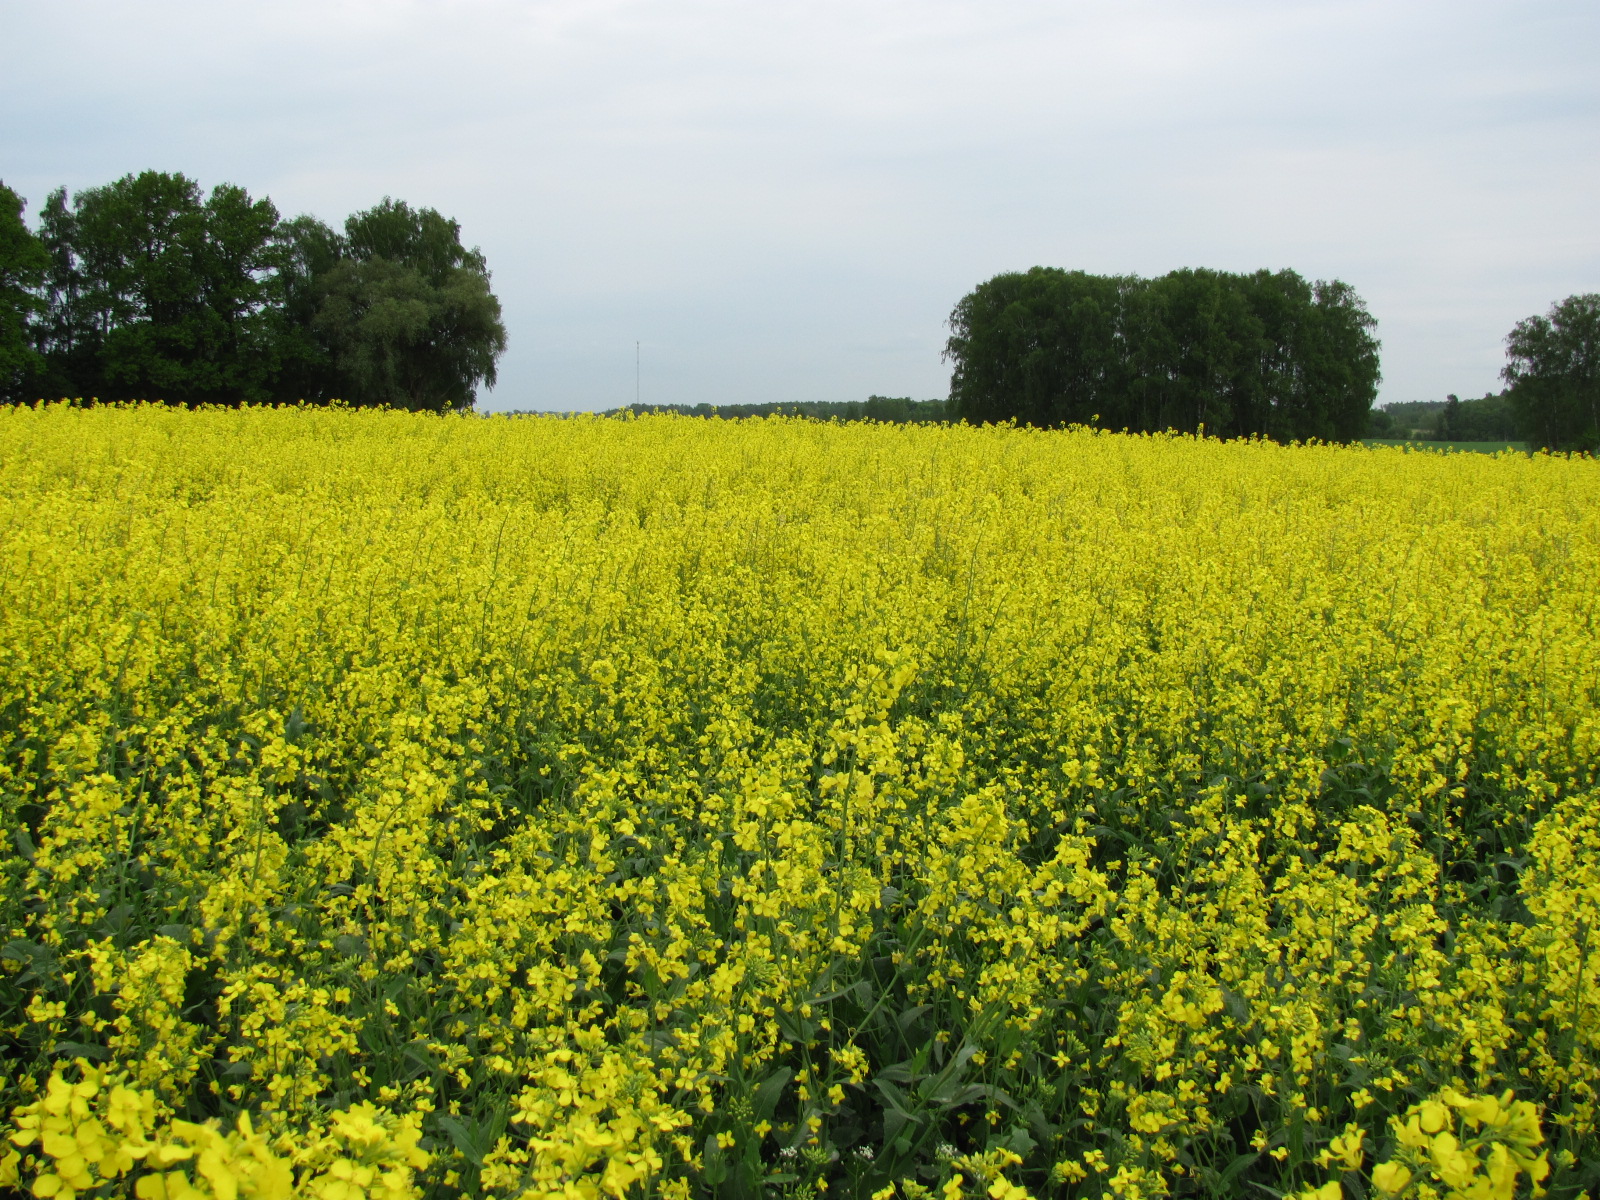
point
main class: Cropland
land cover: Rape and turnip rape
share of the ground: > 75 %
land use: Agriculture (excluding fallow land and kitchen gardens)
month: May
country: LV
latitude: 56.4792
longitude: 24.1325
